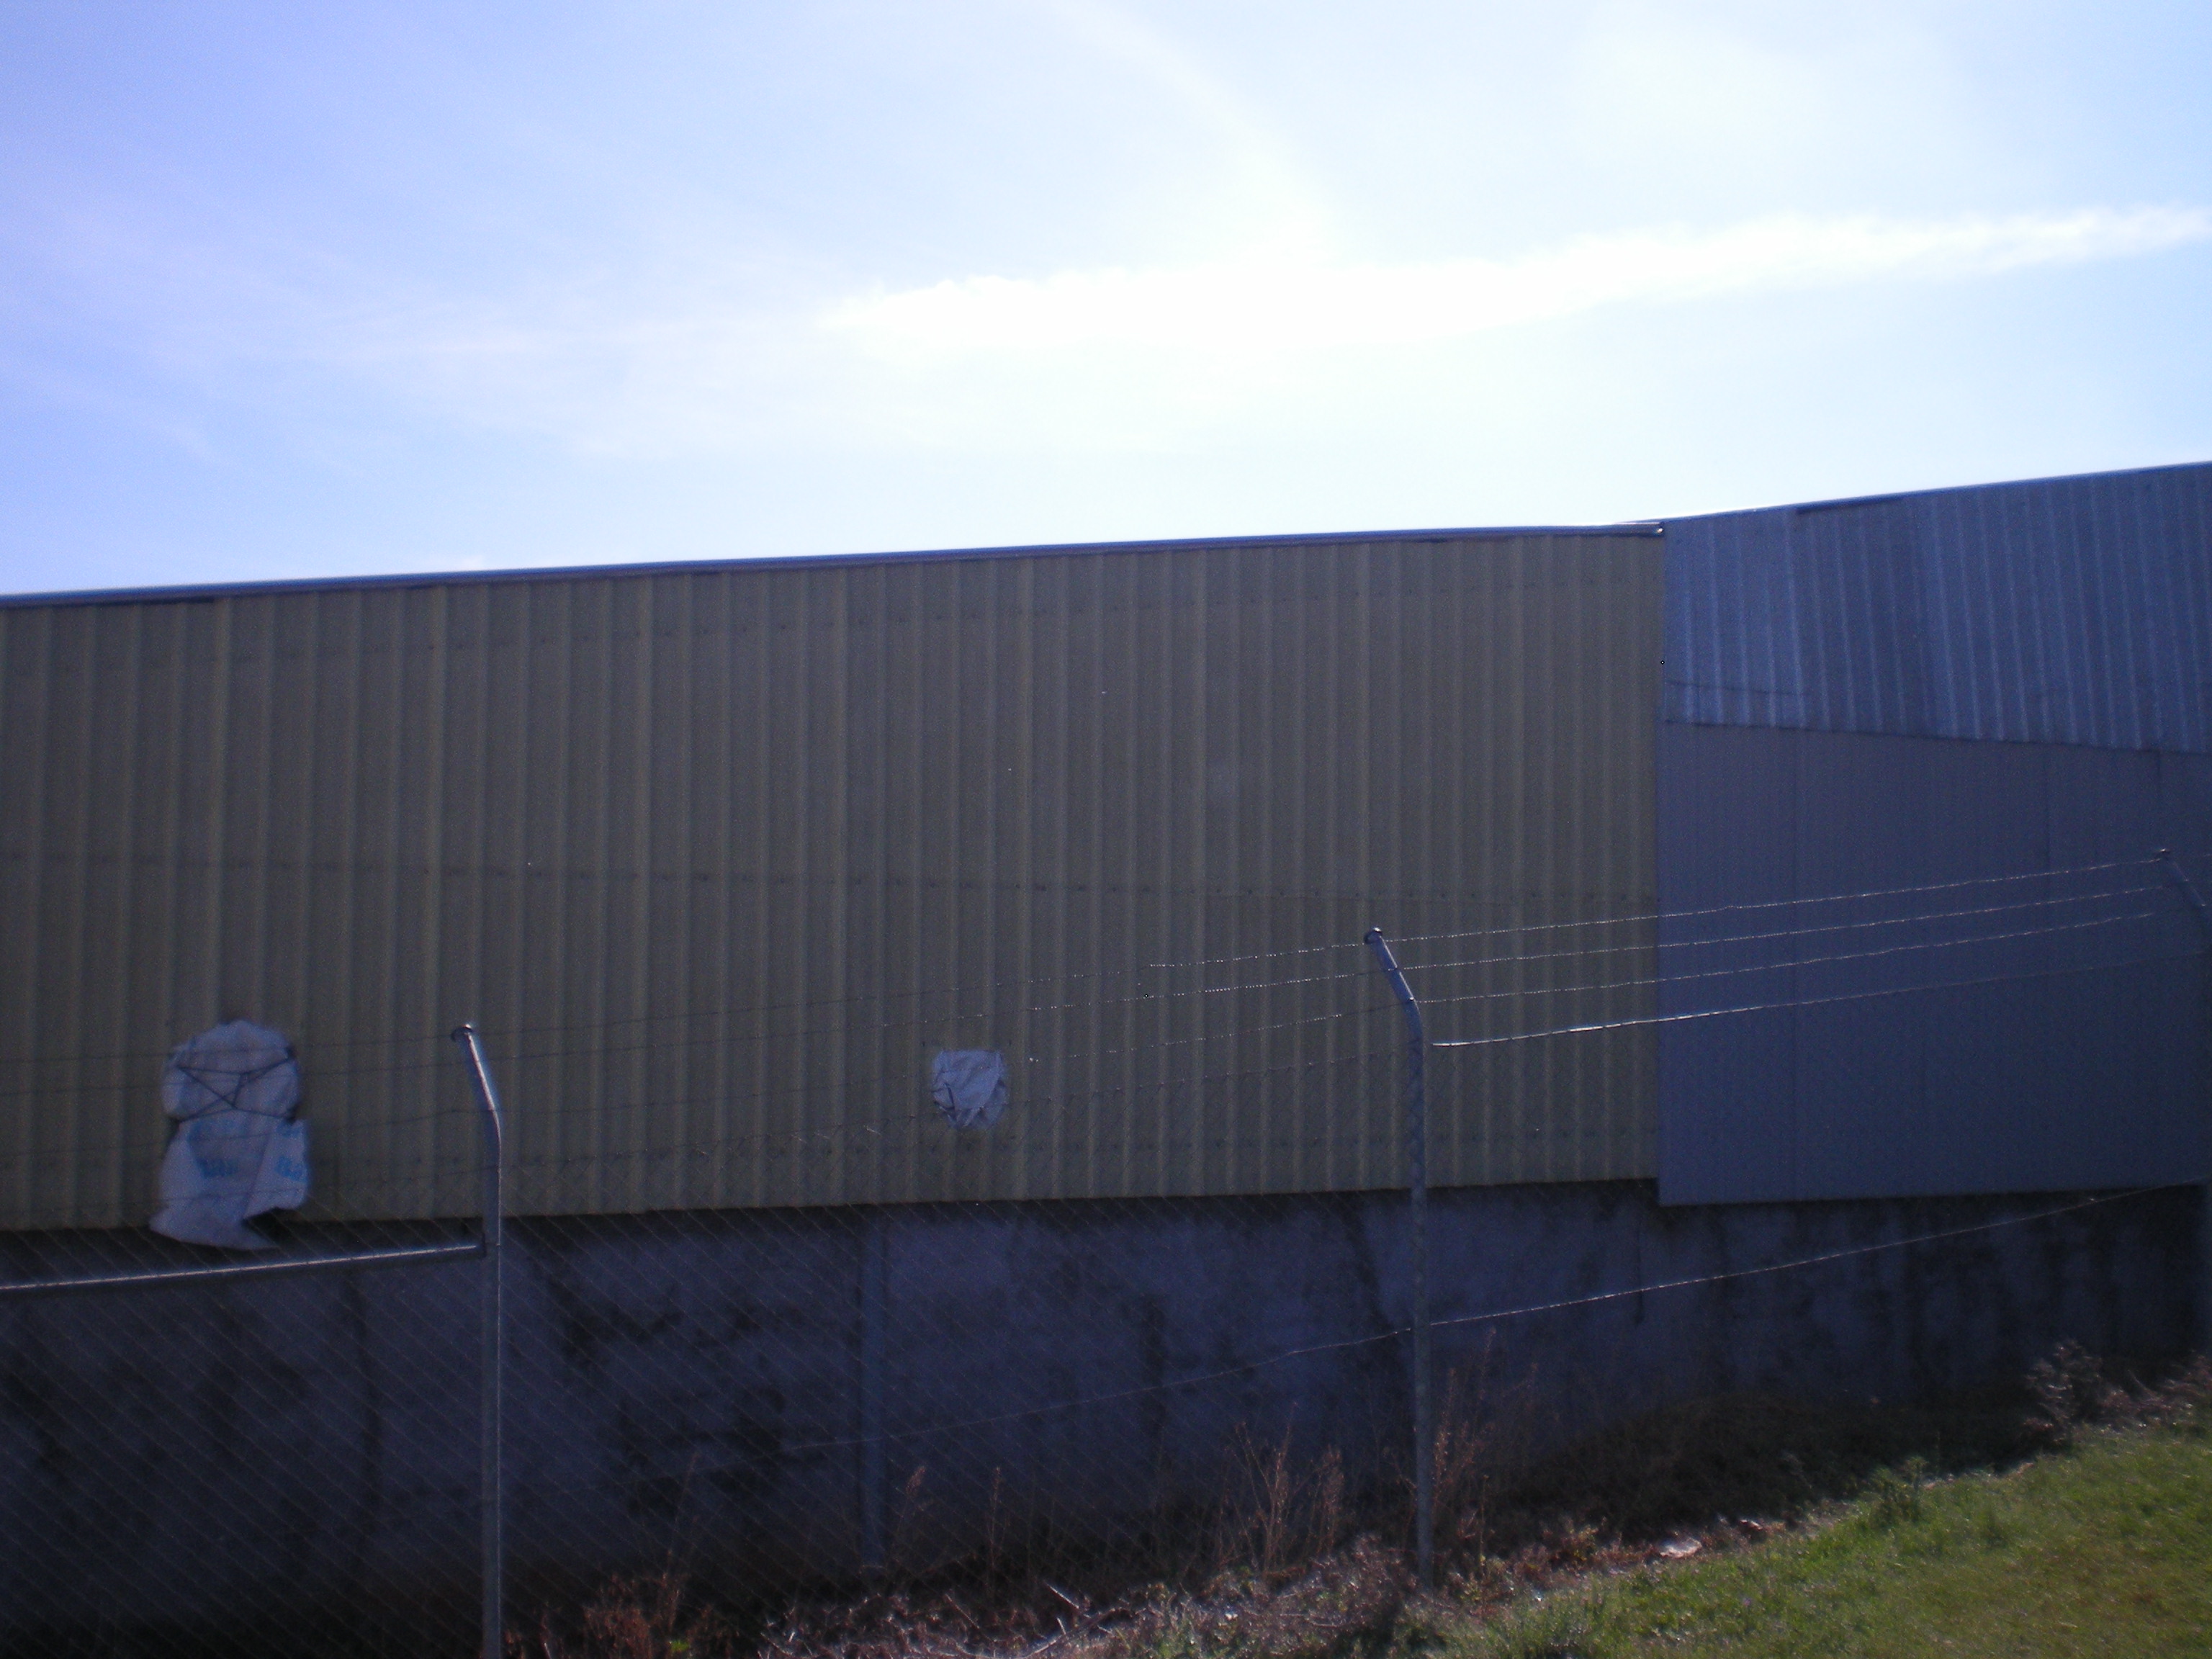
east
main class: Grassland
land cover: Grassland without tree/shrub cover
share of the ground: > 75 %
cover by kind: herbaceous plants 80 %, unconsolidated bare surface 20 %
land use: Agriculture (excluding fallow land and kitchen gardens)
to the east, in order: Grassland without tree/shrub cover; Fences; Artificial constructions in urban areas; Dry stone walls; Fences; Grass margins; Oats; Fences; Grassland without tree/shrub cover; Grassland with sparse tree/shrub cover
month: April
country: ES
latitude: 38.9170
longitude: -3.5668
